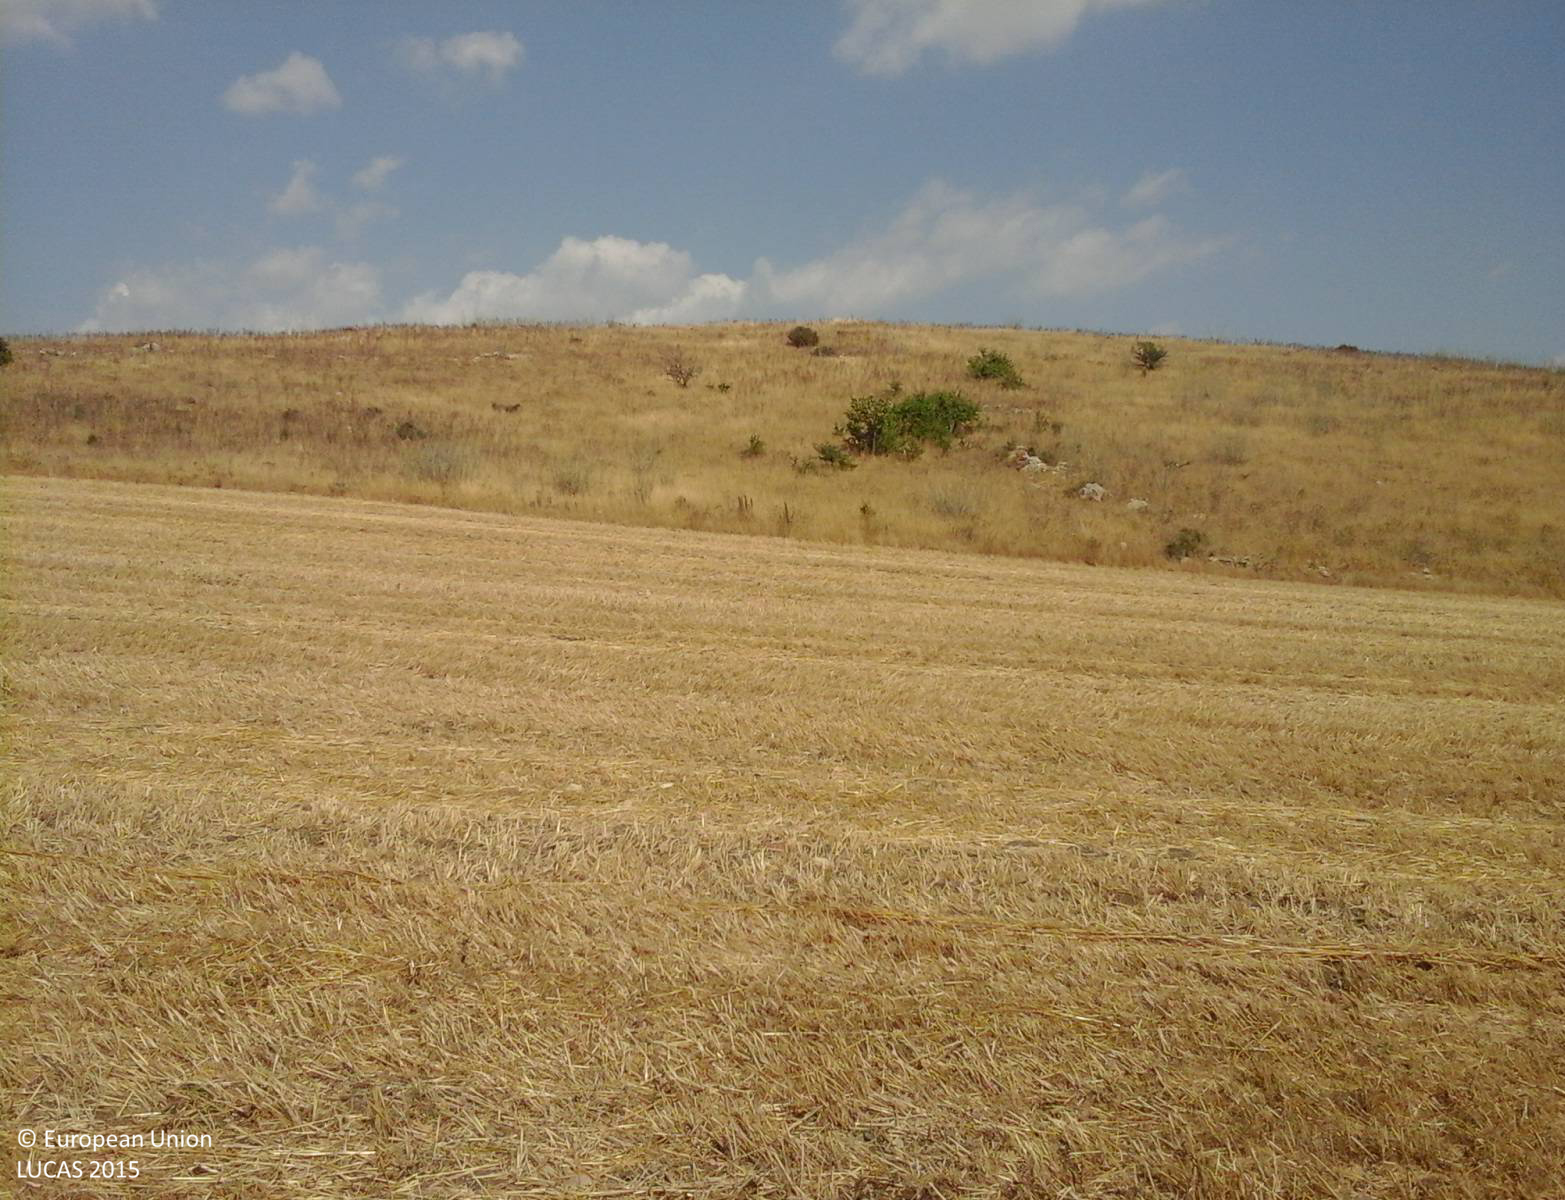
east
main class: Cropland
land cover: Barley
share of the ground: < 10 %
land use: Agriculture (excluding fallow land and kitchen gardens)
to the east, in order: Barley; Grassland without tree/shrub cover; Barley; Spontaneously vegetated surfaces
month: July
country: IT
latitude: 39.7168
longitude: 8.8053
